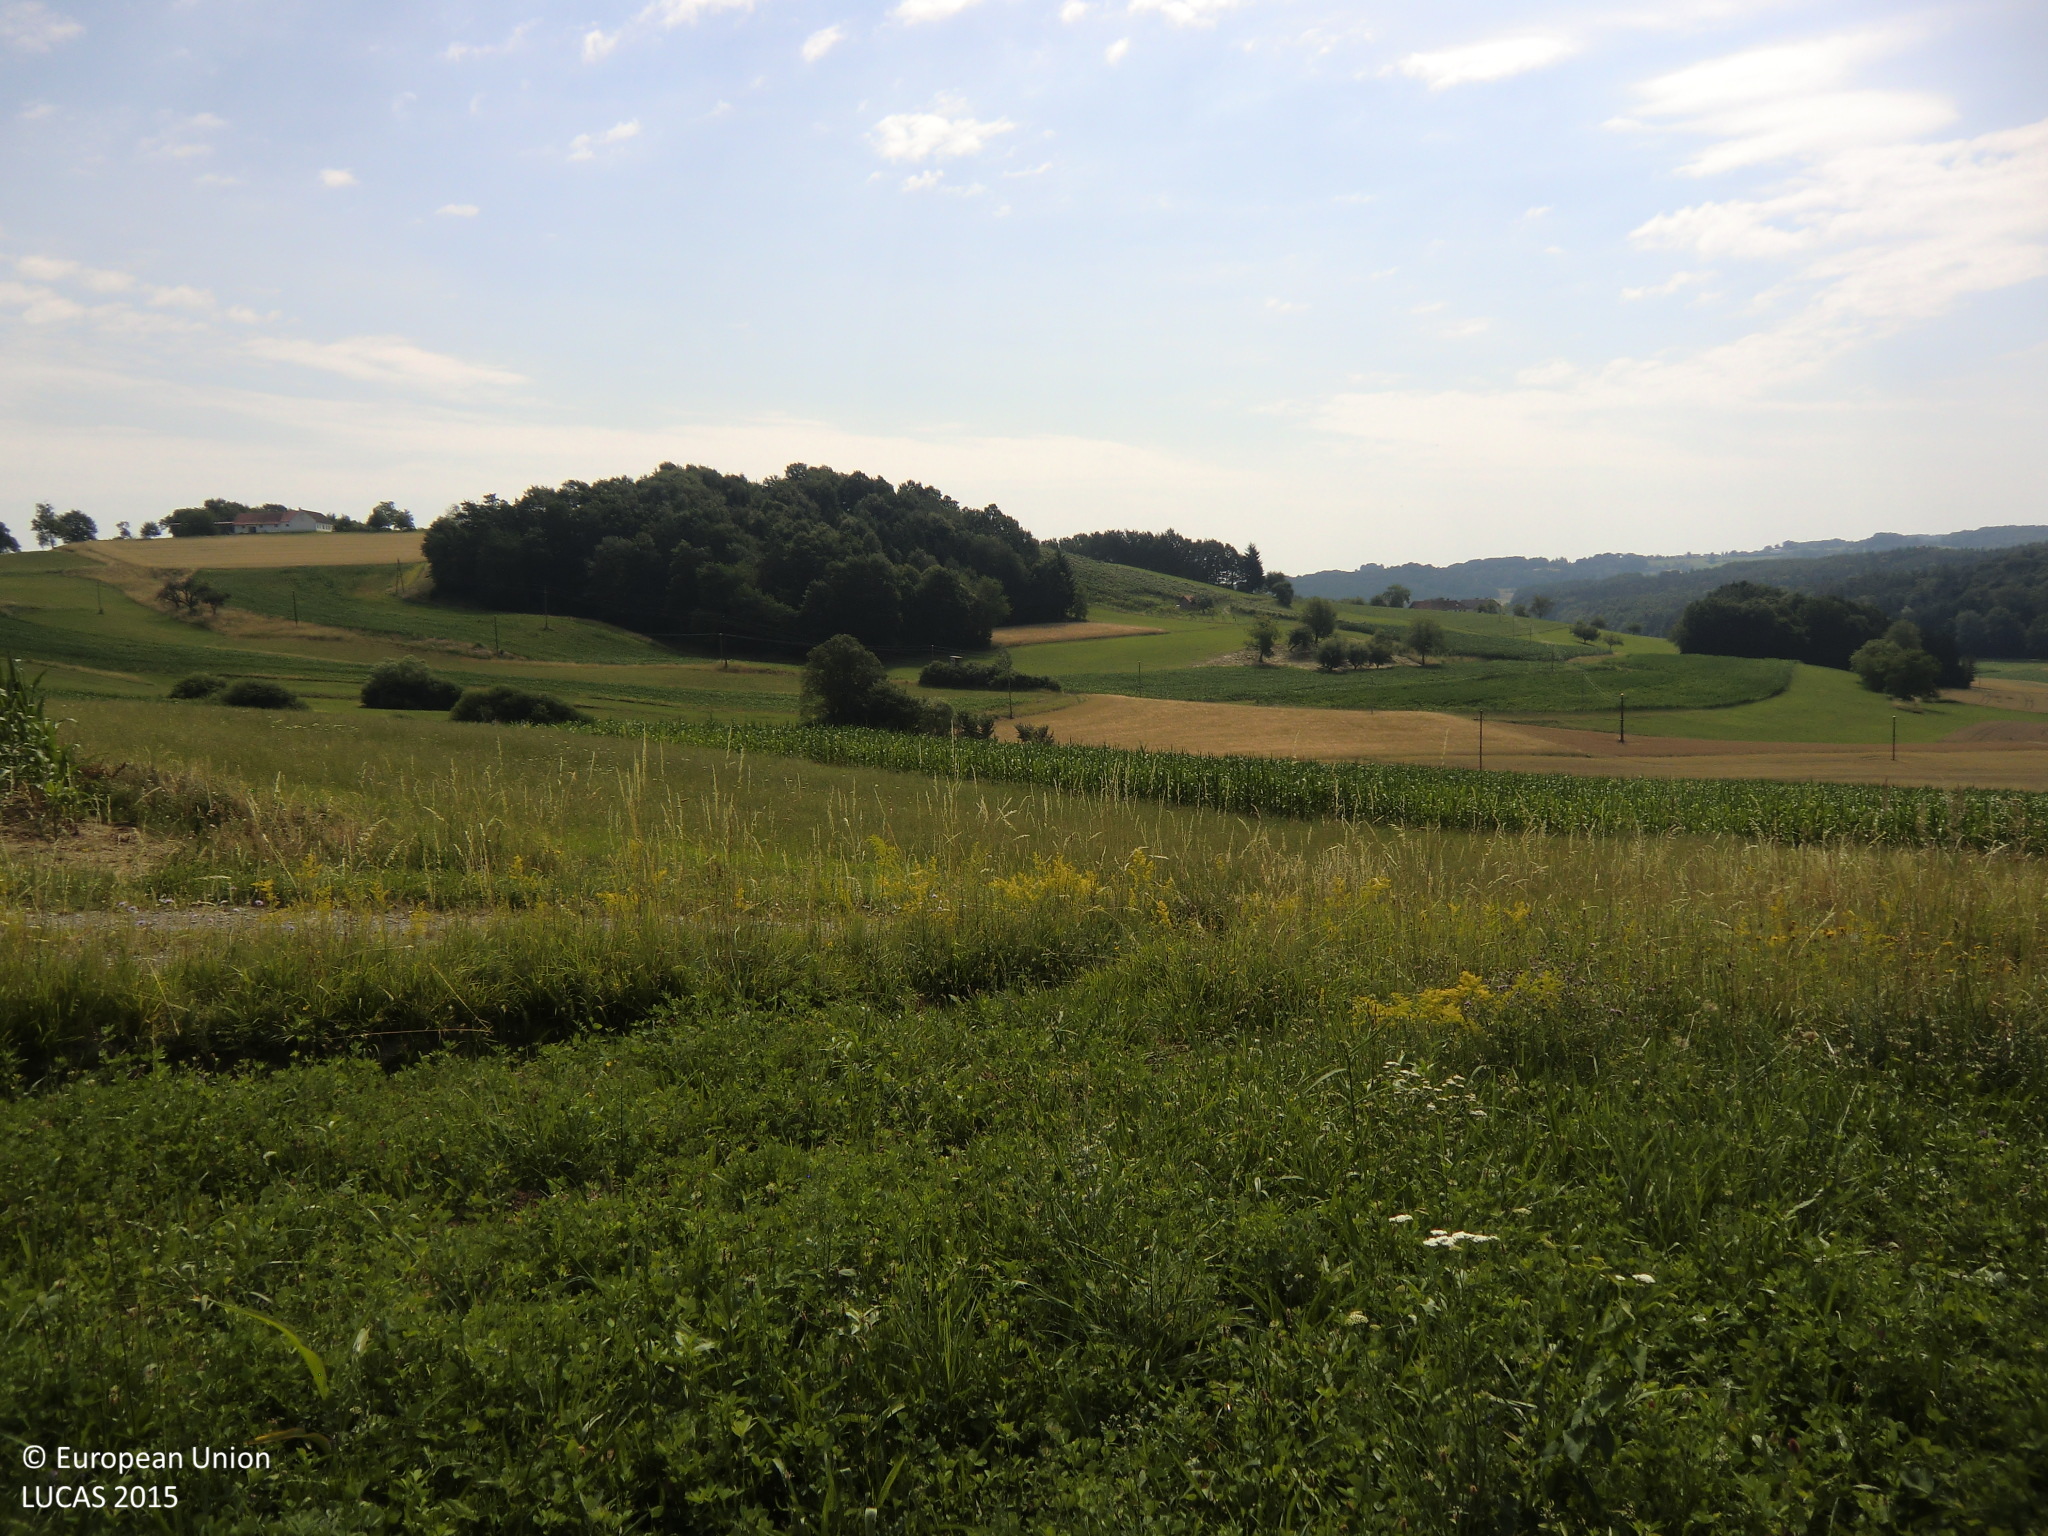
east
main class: Cropland
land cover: Clovers
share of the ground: > 75 %
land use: Agriculture (excluding fallow land and kitchen gardens)
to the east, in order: Clovers; Ditches and canals; Tracks; Grass margins; Maize; Temporary grasslands; Maize; Grassland without tree/shrub cover; Broadleaved woodland; Grassland without tree/shrub cover
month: July
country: AT
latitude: 47.0949
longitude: 16.1541
